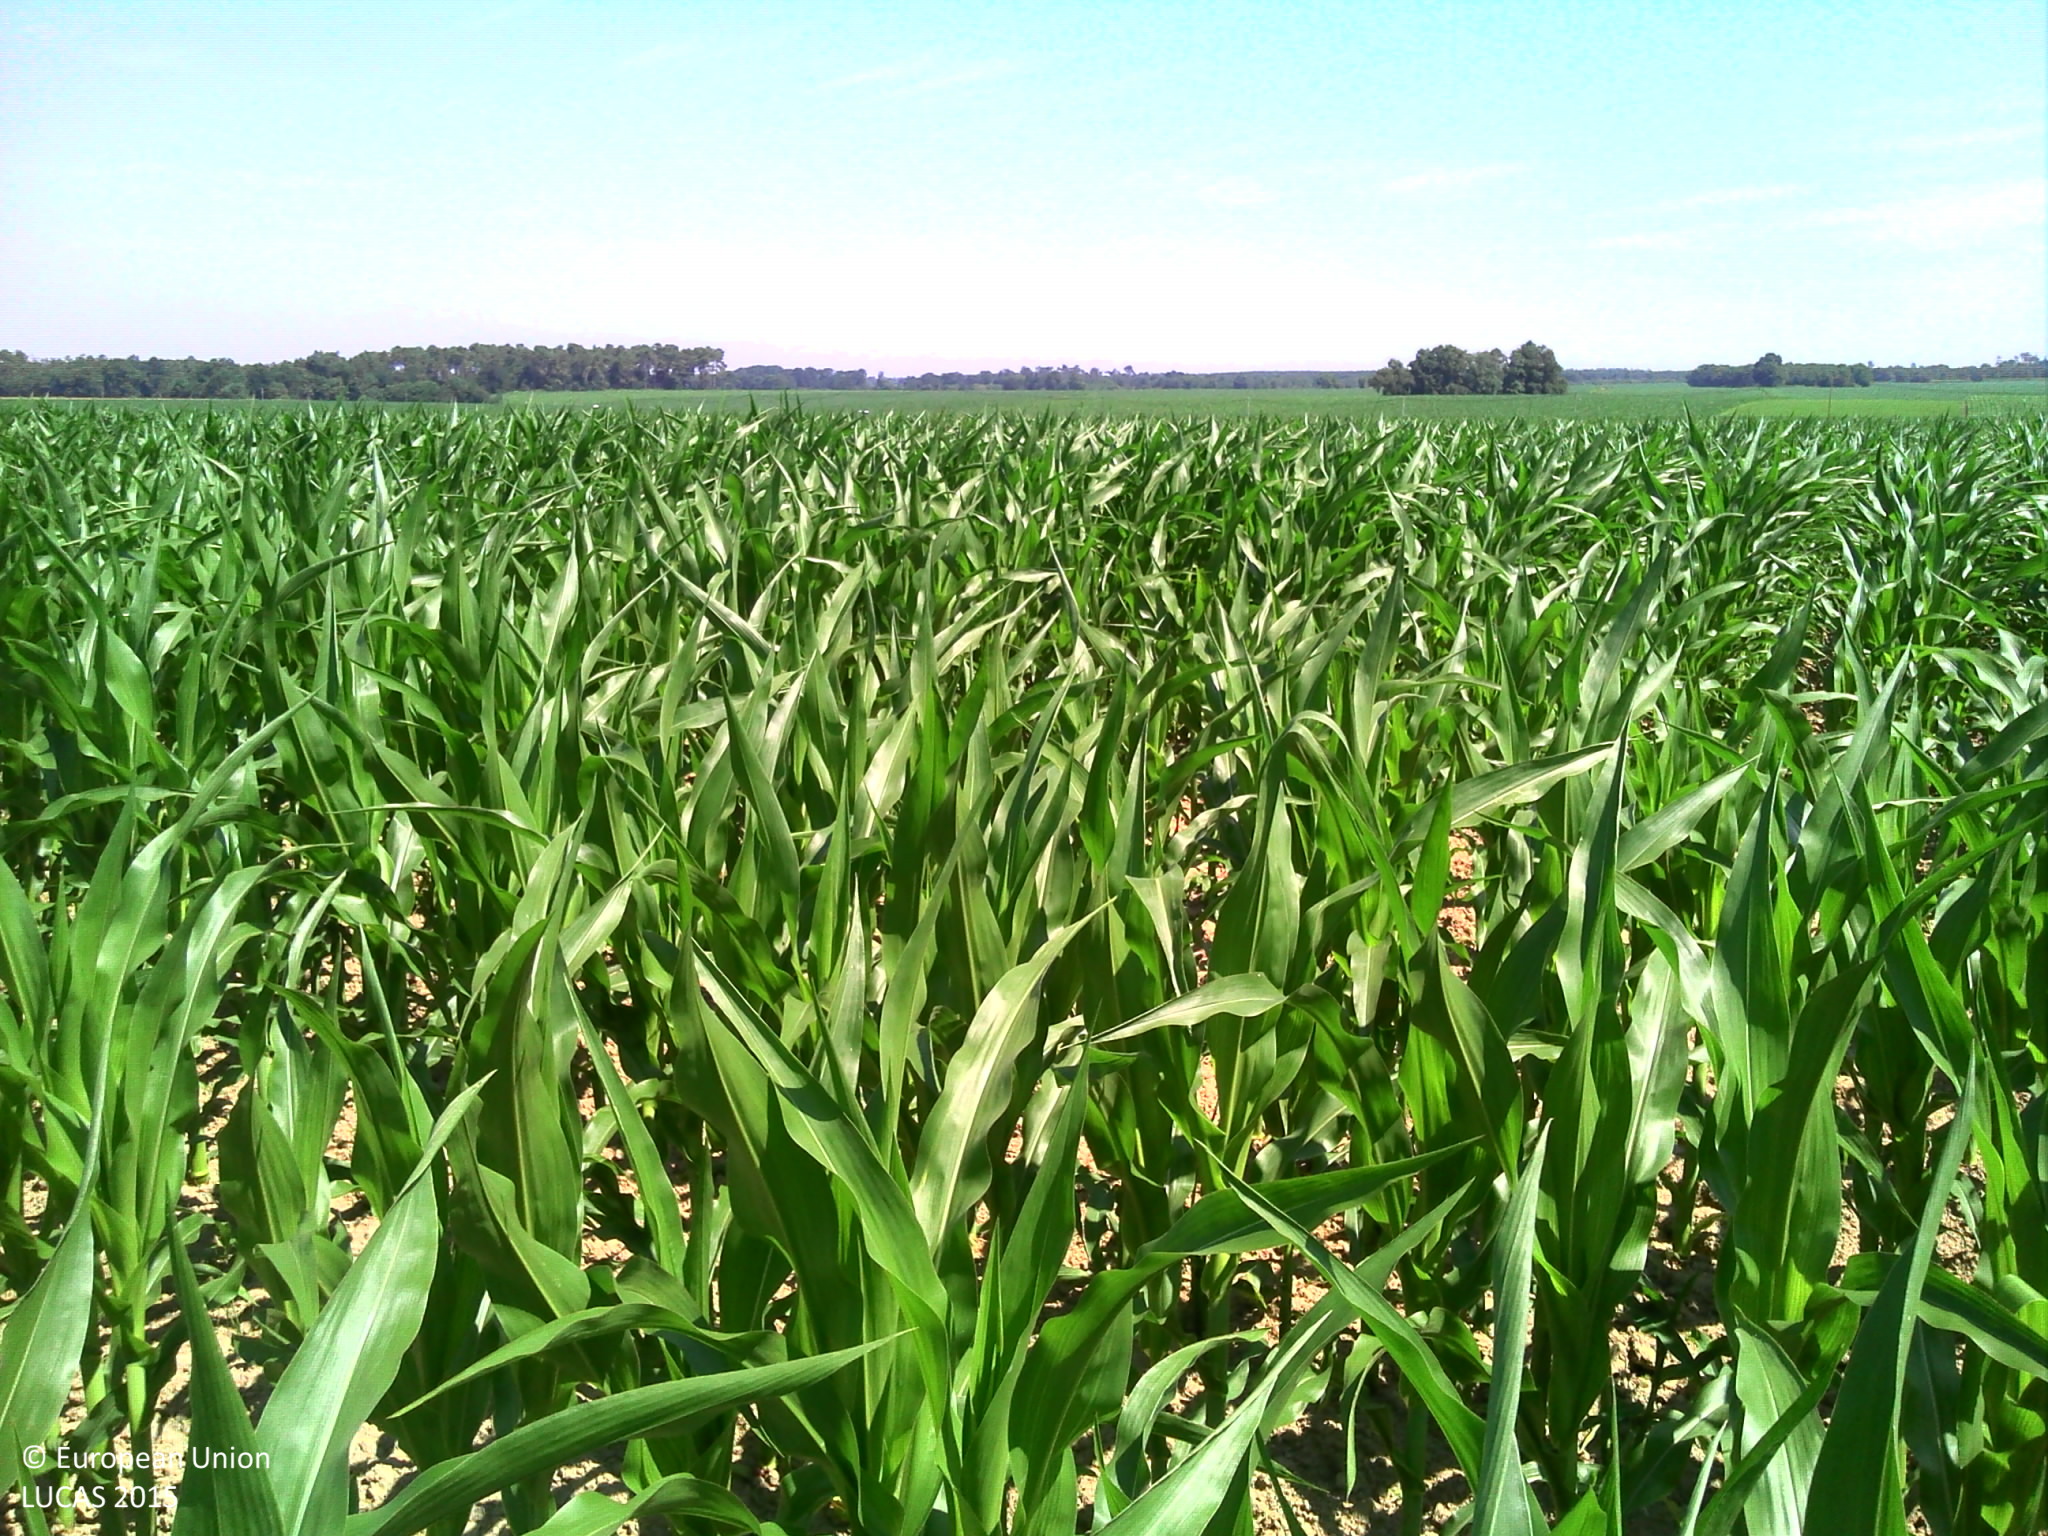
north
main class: Cropland
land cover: Maize
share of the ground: > 75 %
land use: Agriculture (excluding fallow land and kitchen gardens)
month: June
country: FR
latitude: 43.6108
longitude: -0.5545
